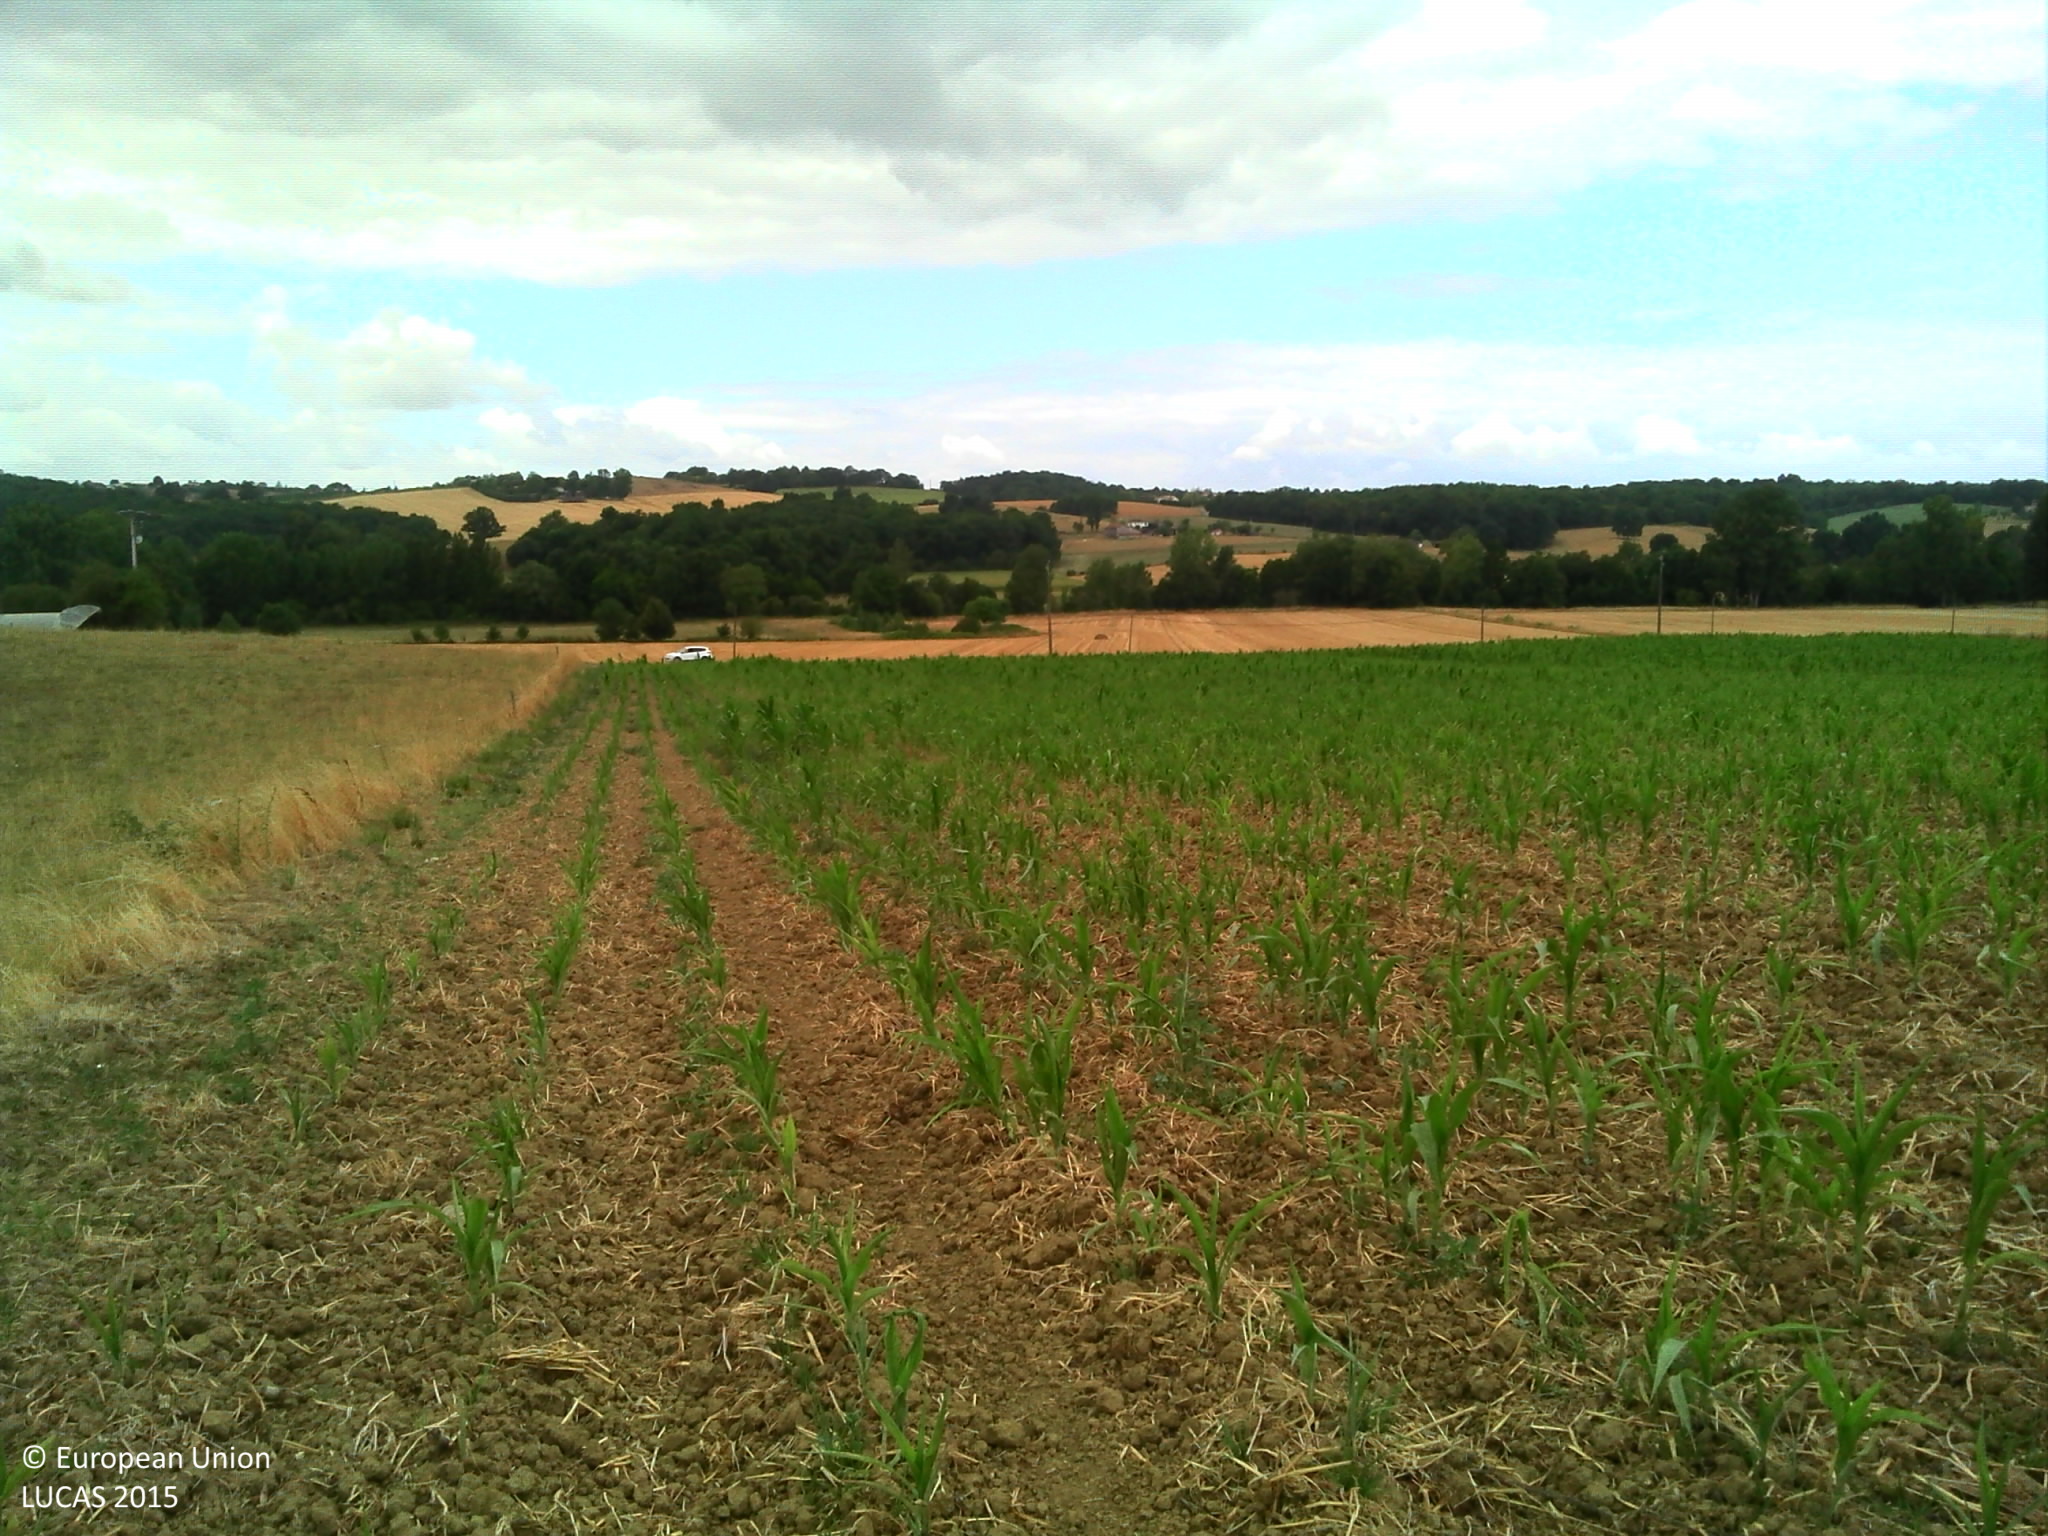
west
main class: Cropland
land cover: Maize
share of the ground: 10 - 25 %
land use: Agriculture (excluding fallow land and kitchen gardens)
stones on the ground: < 10 %
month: July
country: FR
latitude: 44.4632
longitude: 0.5534
